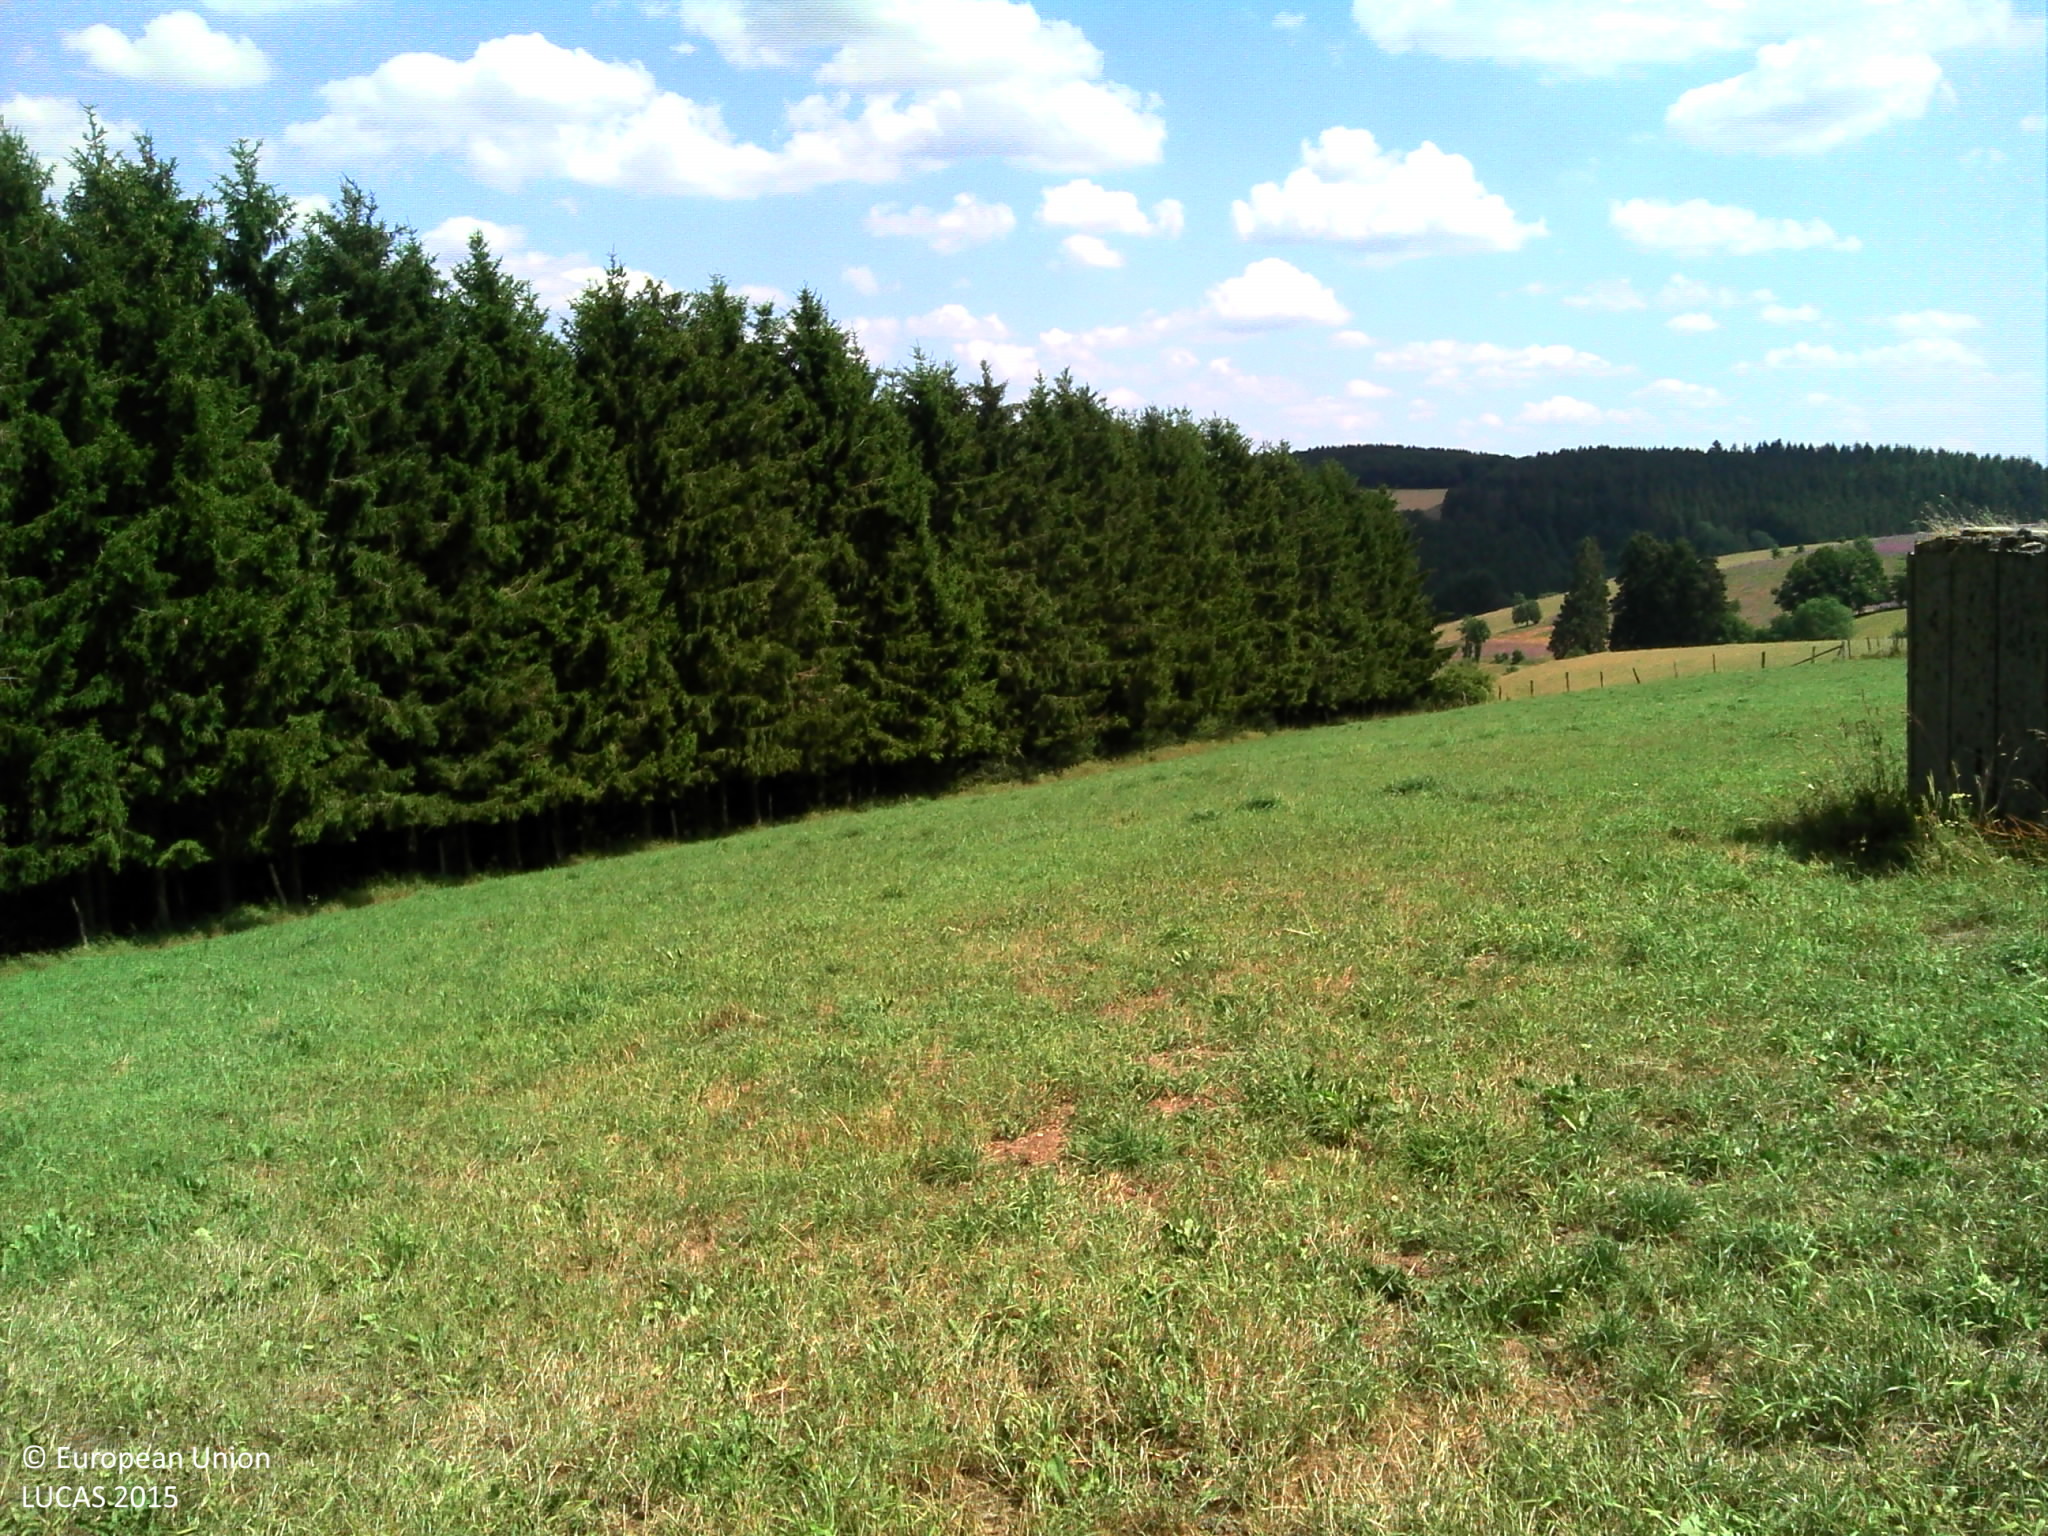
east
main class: Grassland
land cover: Grassland without tree/shrub cover
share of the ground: > 75 %
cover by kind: herbaceous plants 95 %, unconsolidated bare surface 5 %
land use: Agriculture (excluding fallow land and kitchen gardens)
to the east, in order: Grassland without tree/shrub cover; Fences; Spruce dominated coniferous woodland; Grass margins; Rivers and streams; Fences; Grassland without tree/shrub cover; Fences; Grassland without tree/shrub cover; Fences; Grassland without tree/shrub cover; Fences; Abandoned hedges; Spruce dominated coniferous woodland; Fences; Broadleaved woodland; Grassland with sparse tree/shrub cover
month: July
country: BE
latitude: 49.9250
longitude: 5.7503
